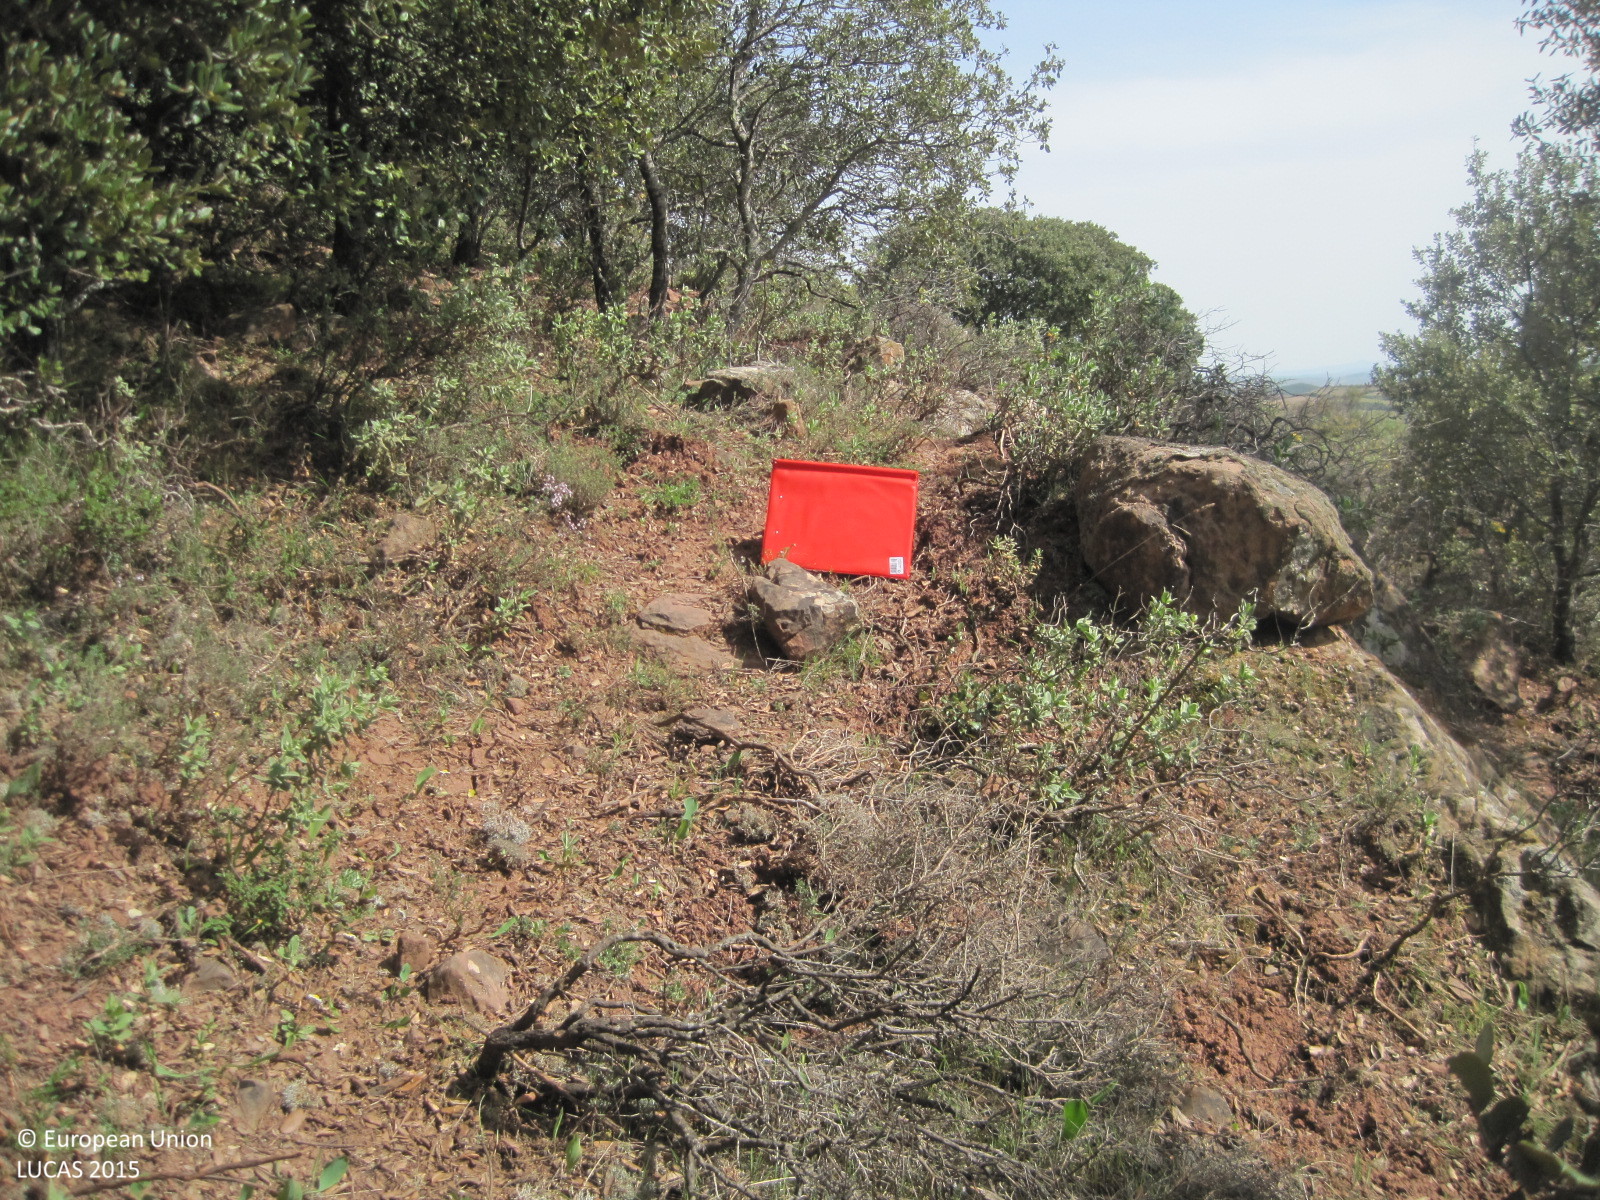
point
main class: Woodland
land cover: Broadleaved woodland
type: broadleaved evergreen forest
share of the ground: 50 - 75 %
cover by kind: broadleaved forest trees 50 %, shrubs 30 %, unconsolidated bare surface 15 %, consolidated bare surface 5 %
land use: Semi-natural and natural areas not in use
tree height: > 5 m
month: April
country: ES
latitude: 42.6133
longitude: -2.2959
